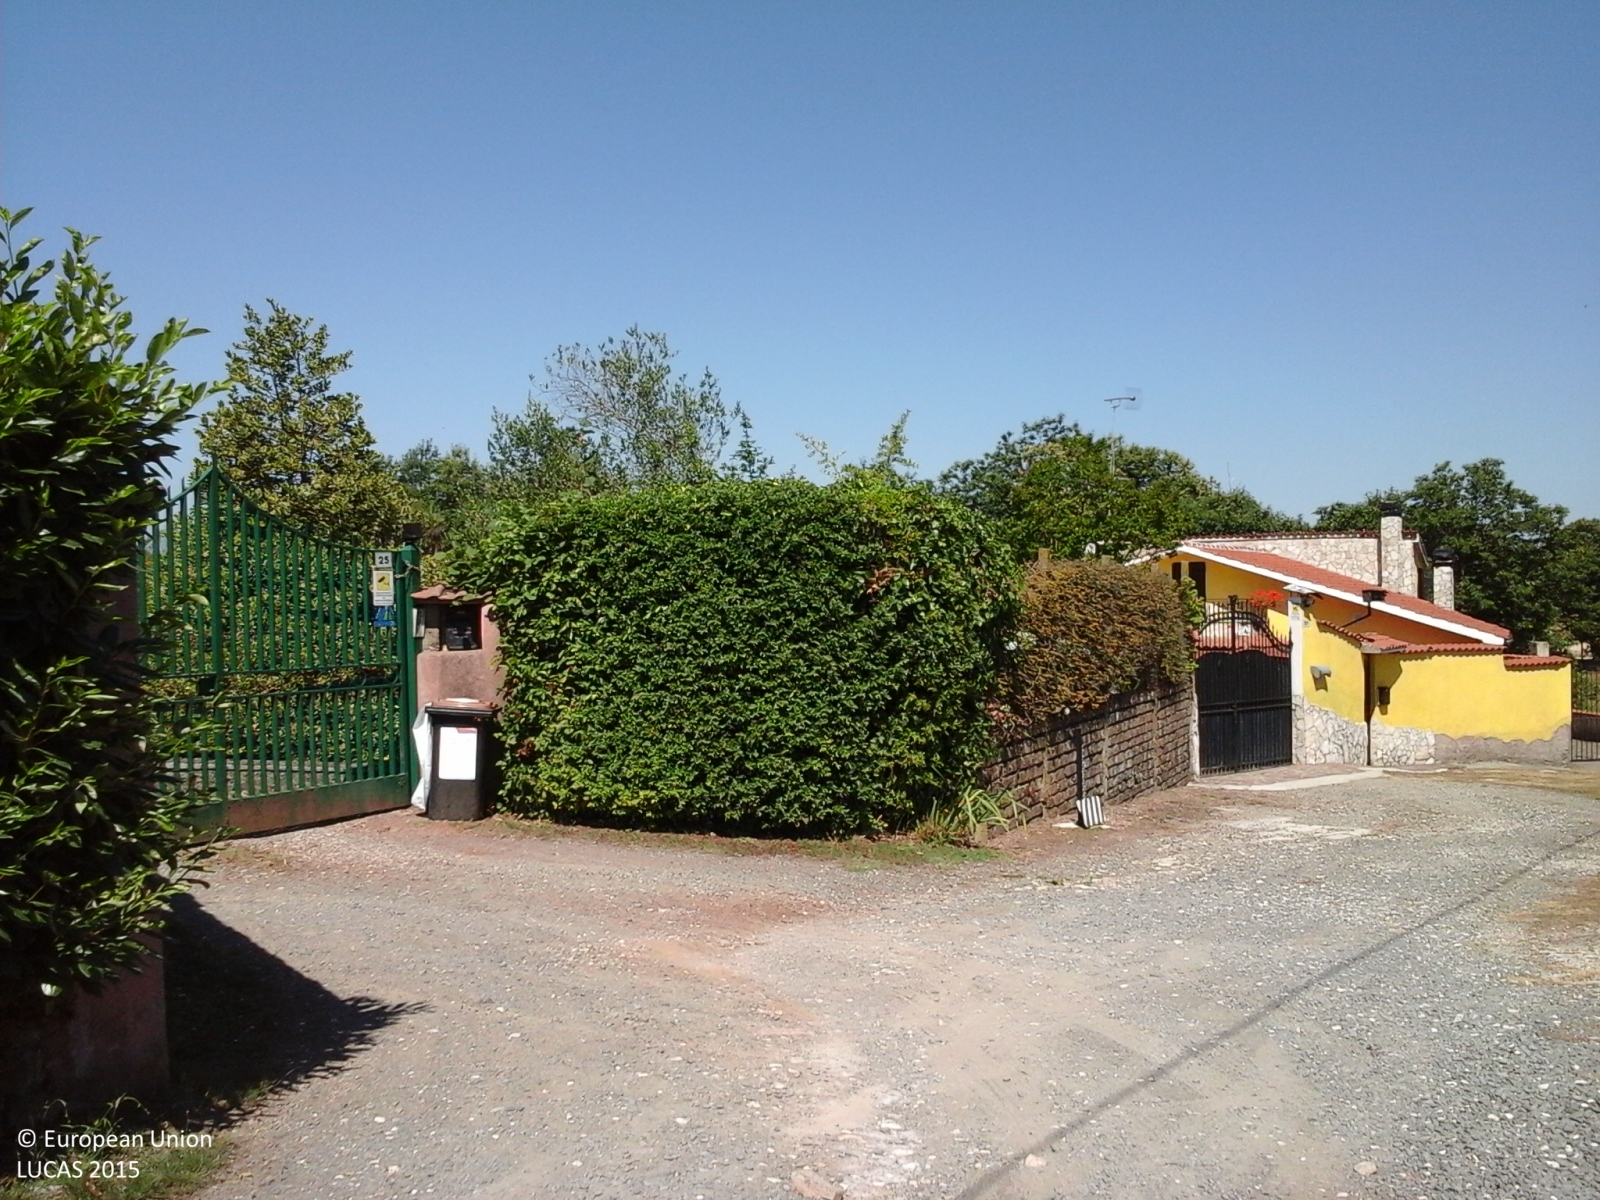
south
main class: Grassland
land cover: Grassland without tree/shrub cover
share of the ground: > 75 %
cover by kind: herbaceous plants 100 %
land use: Agriculture (excluding fallow land and kitchen gardens)
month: July
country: IT
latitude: 41.8188
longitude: 12.8425
